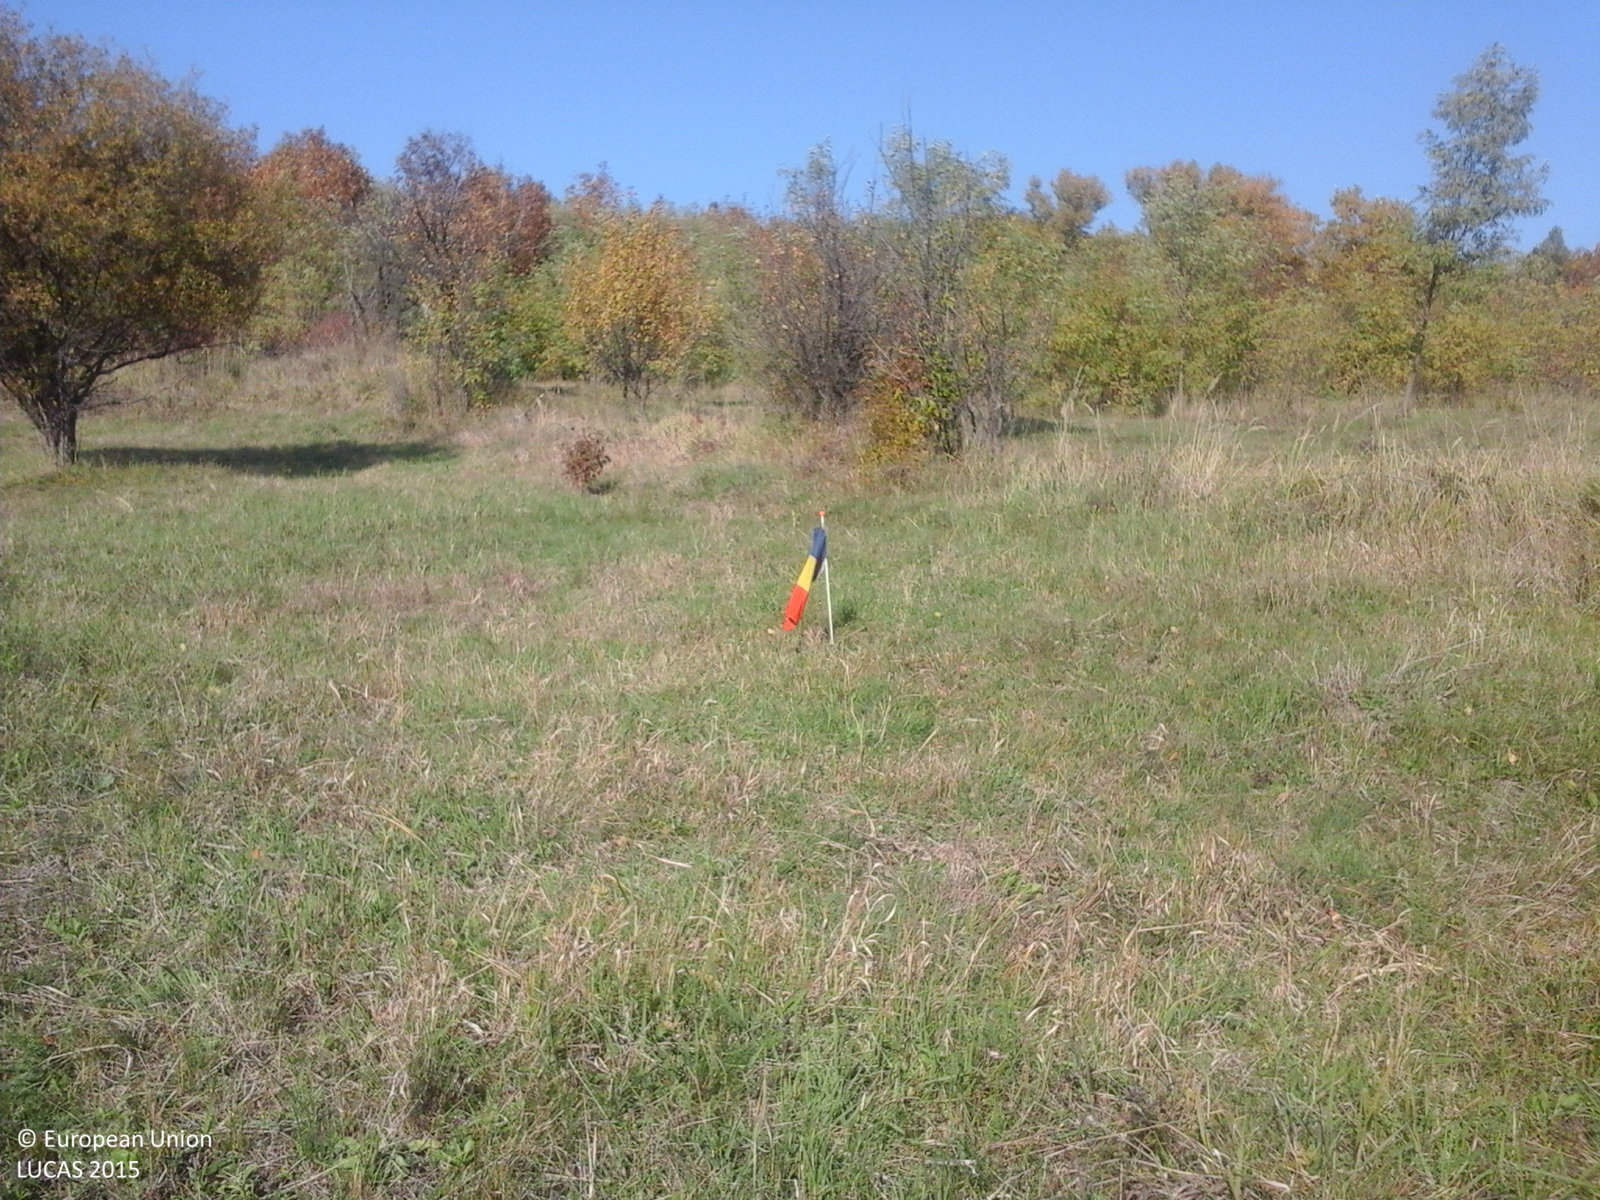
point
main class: Cropland
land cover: Other fruit trees and berries
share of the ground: > 75 %
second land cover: Grassland without tree/shrub cover
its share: > 75 %
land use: Agriculture (excluding fallow land and kitchen gardens)
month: October
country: RO
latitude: 45.3053
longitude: 26.5650
